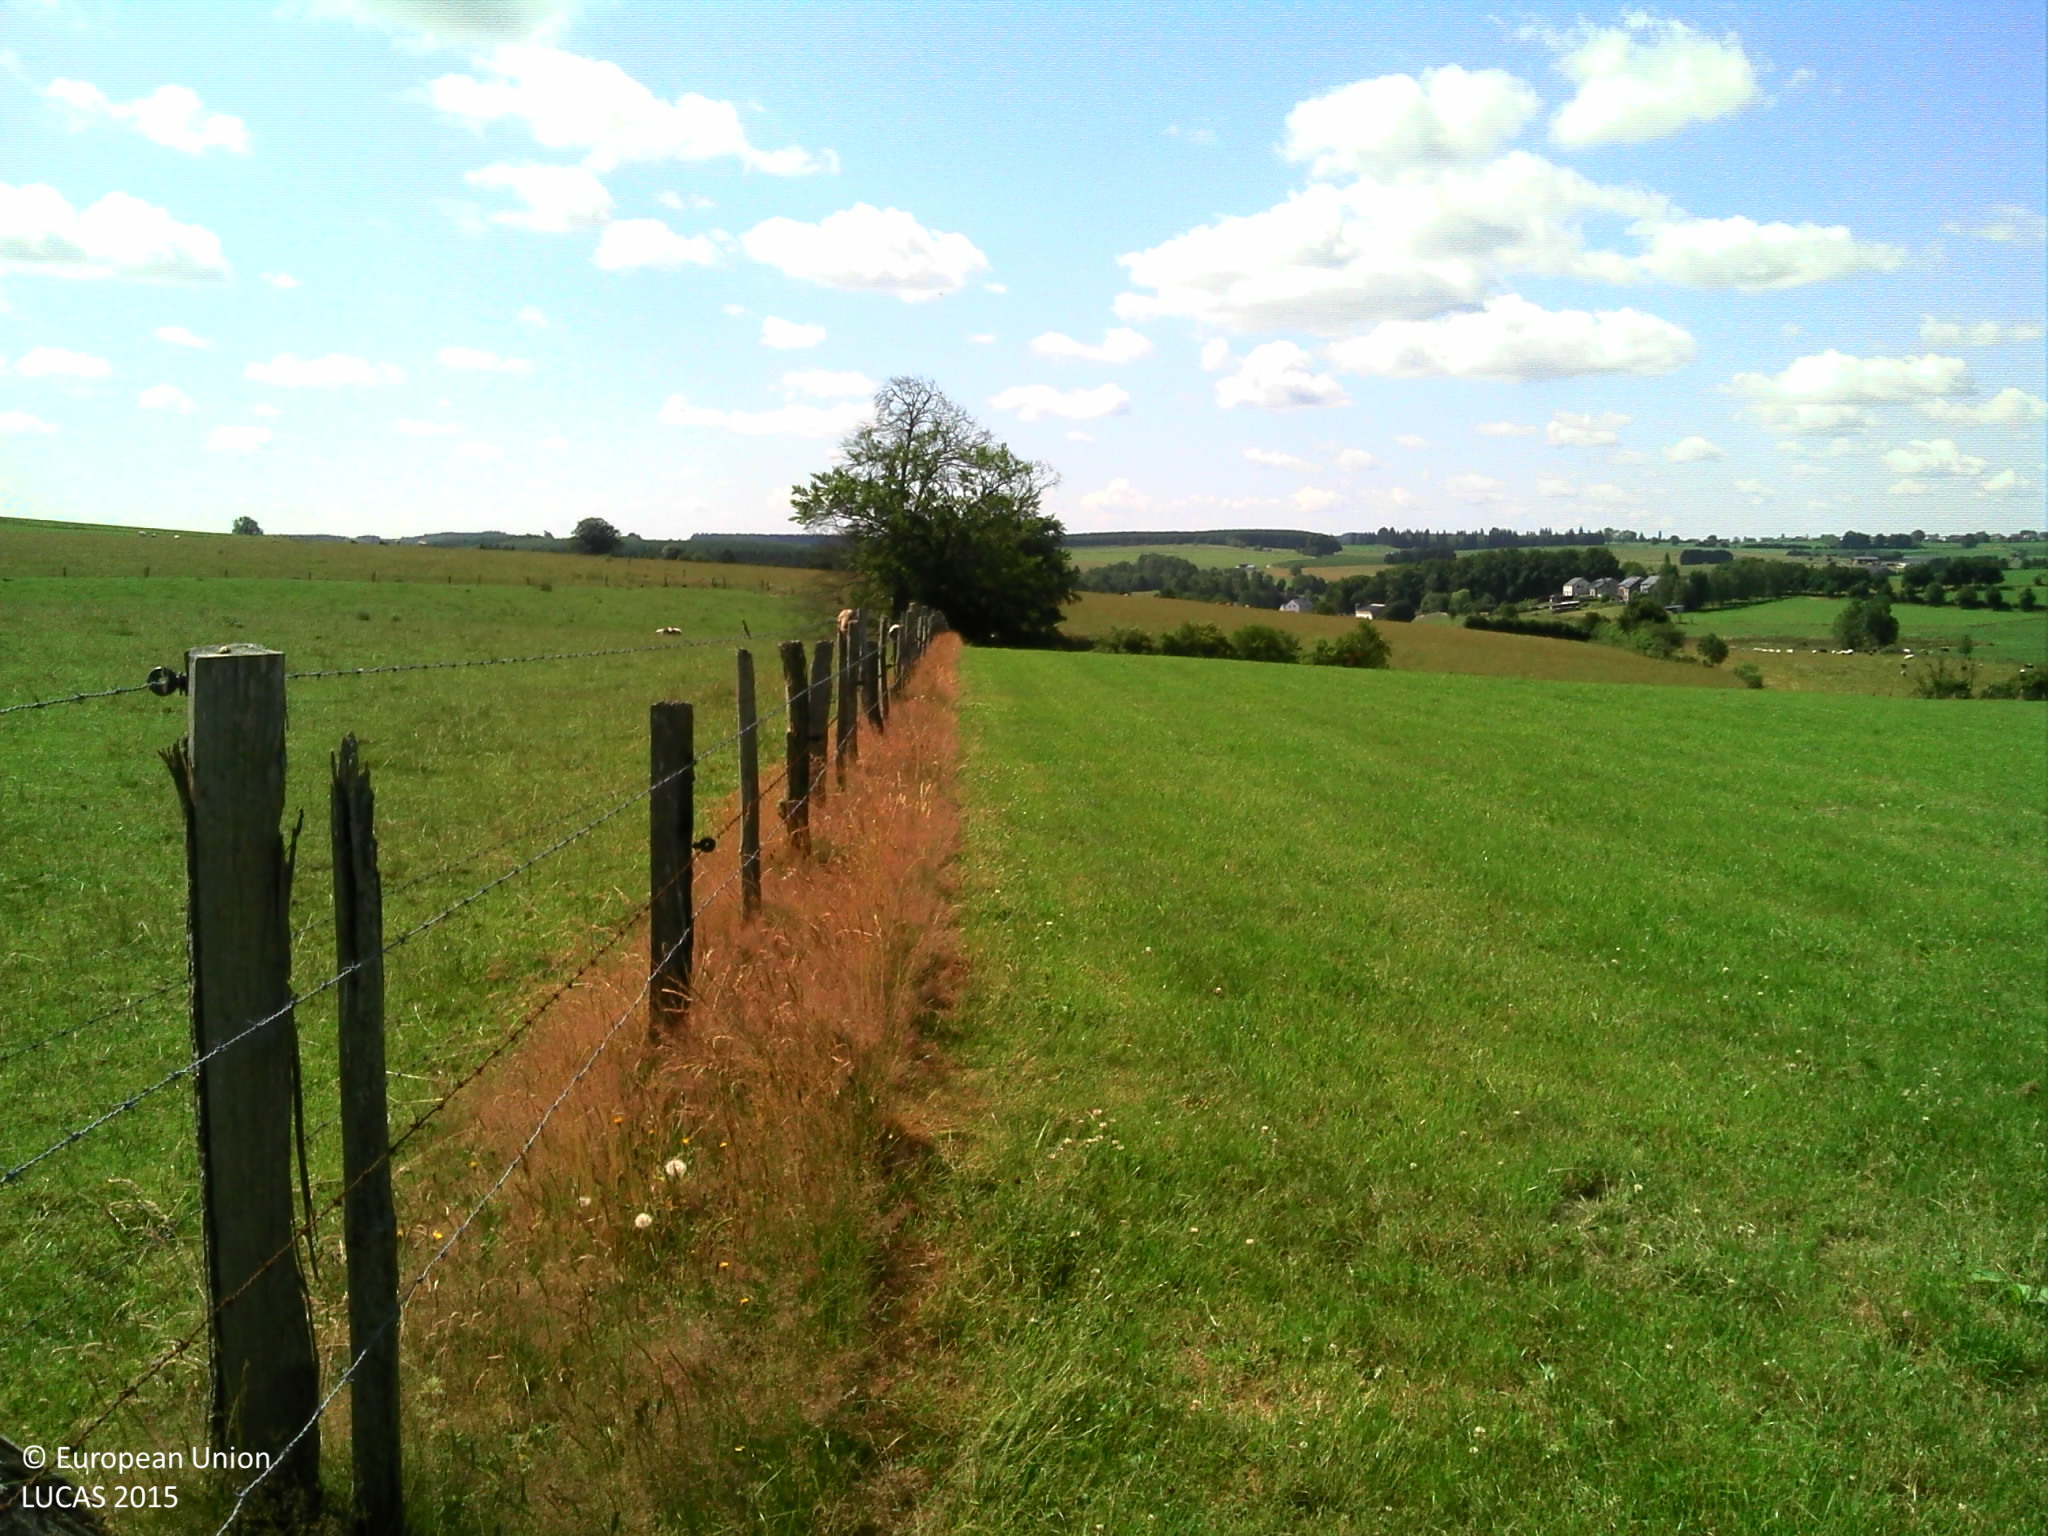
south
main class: Grassland
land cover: Grassland without tree/shrub cover
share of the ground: > 75 %
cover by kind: herbaceous plants 100 %
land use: Agriculture (excluding fallow land and kitchen gardens)
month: July
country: BE
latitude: 50.0158
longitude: 5.7702
